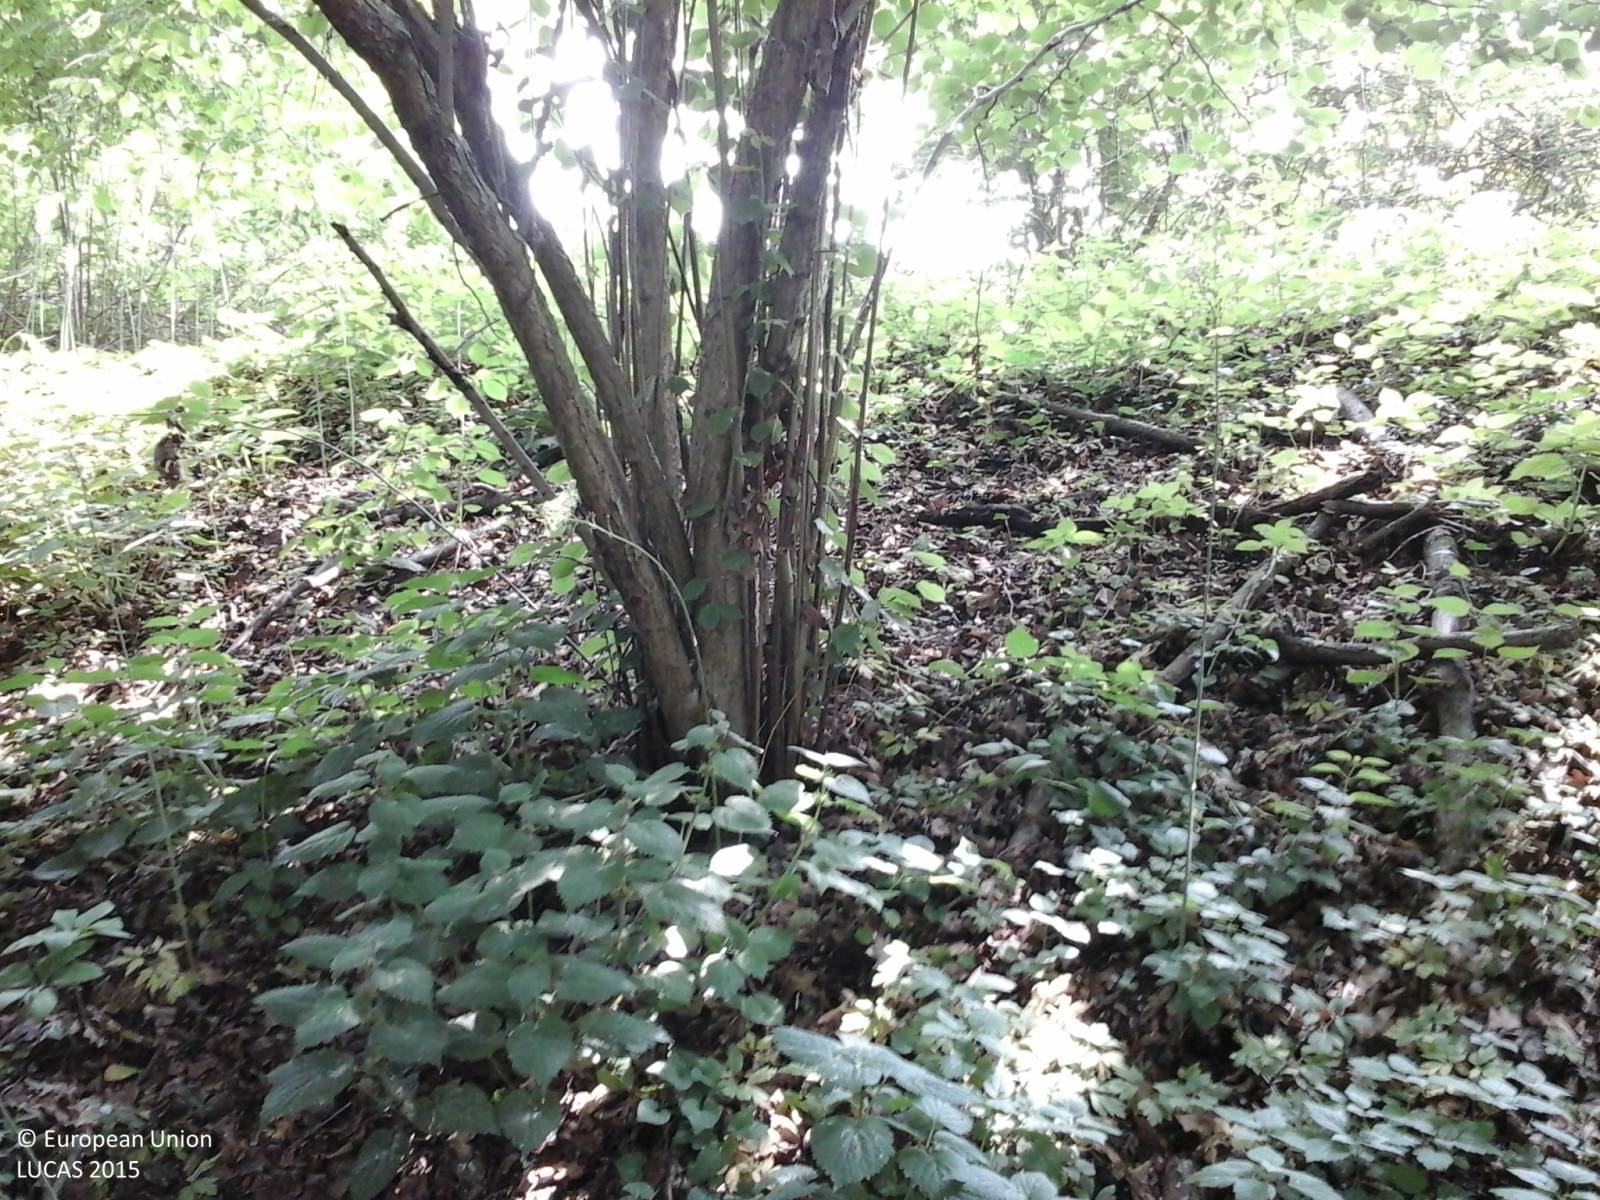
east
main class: Woodland
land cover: Broadleaved woodland
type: thermophilous deciduous forest
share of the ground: > 75 %
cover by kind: broadleaved forest trees 80 %, shrubs 20 %
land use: Forestry
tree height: > 5 m
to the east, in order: Broadleaved woodland; Soya; Ditches and canals; Soya; Grass margins; Tracks; Grass margins; Ditches and canals; Broadleaved woodland
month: May
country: IT
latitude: 45.8698
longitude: 13.2296
